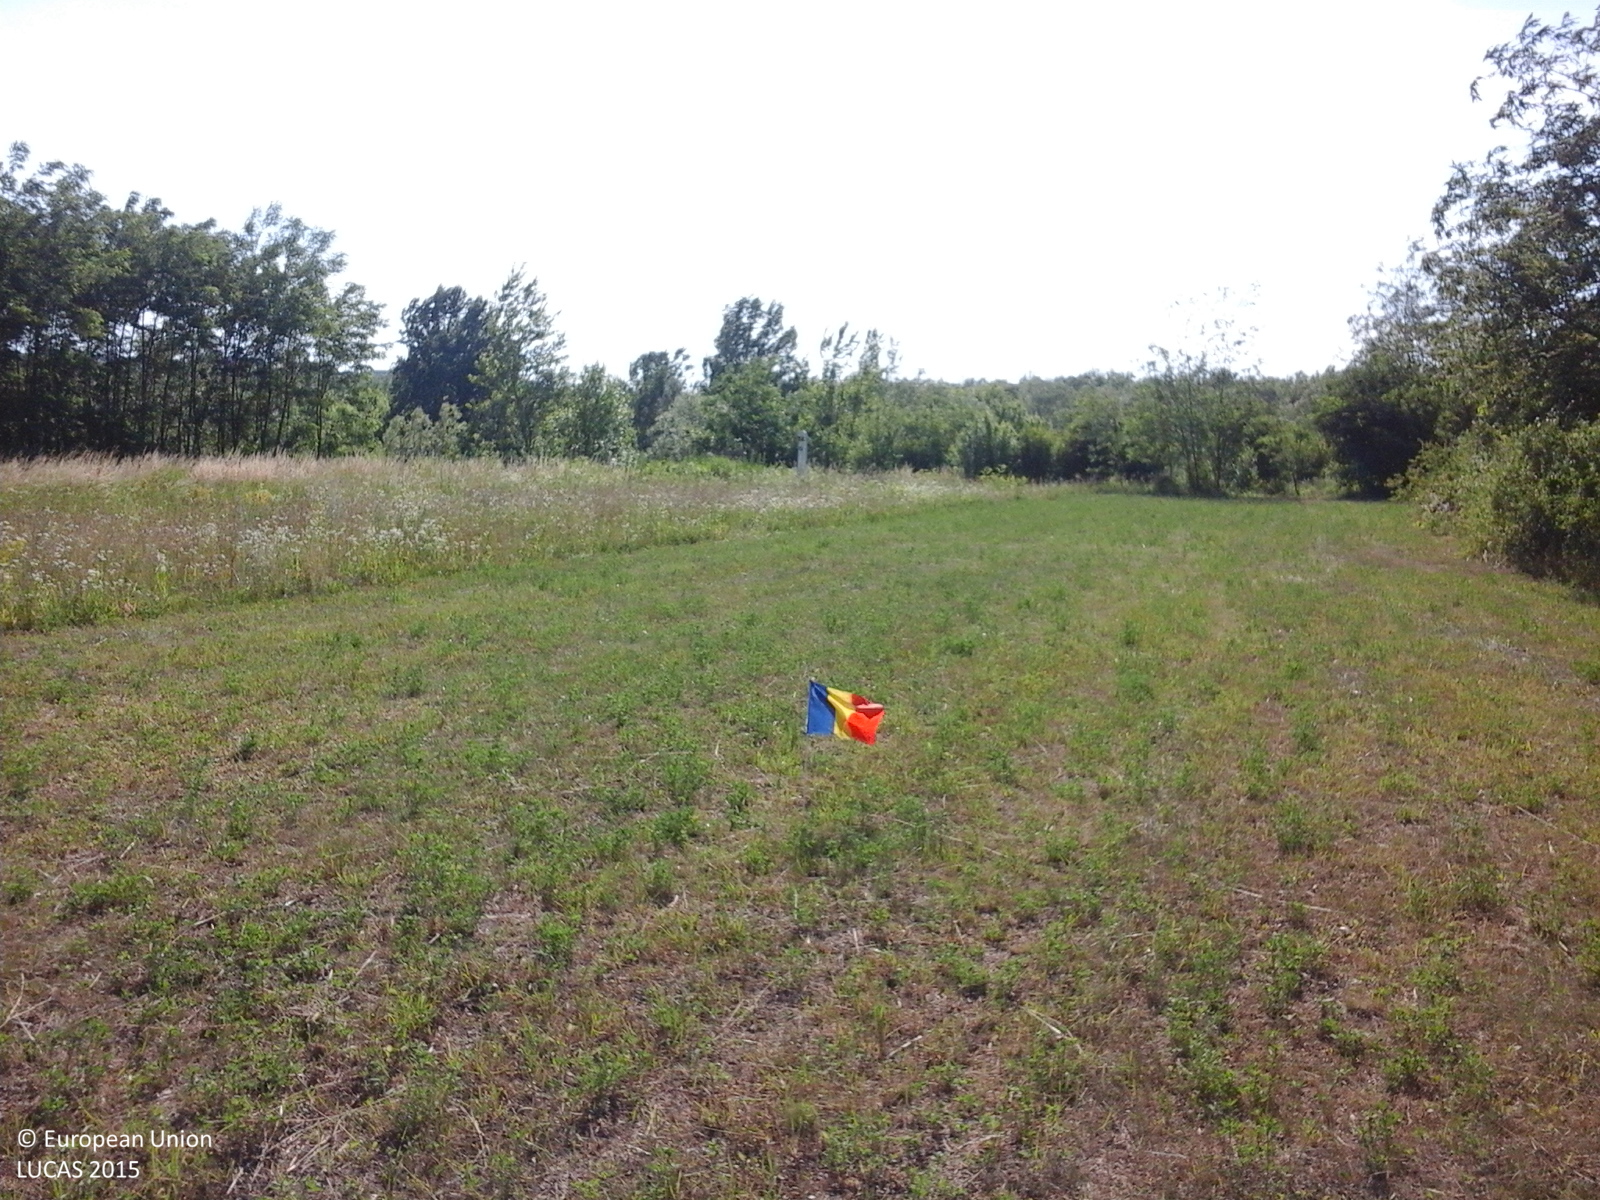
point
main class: Cropland
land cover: Other leguminous and mixtures for fodder
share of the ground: 25 - 50 %
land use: Agriculture (excluding fallow land and kitchen gardens)
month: June
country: RO
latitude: 48.2471
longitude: 26.7871
